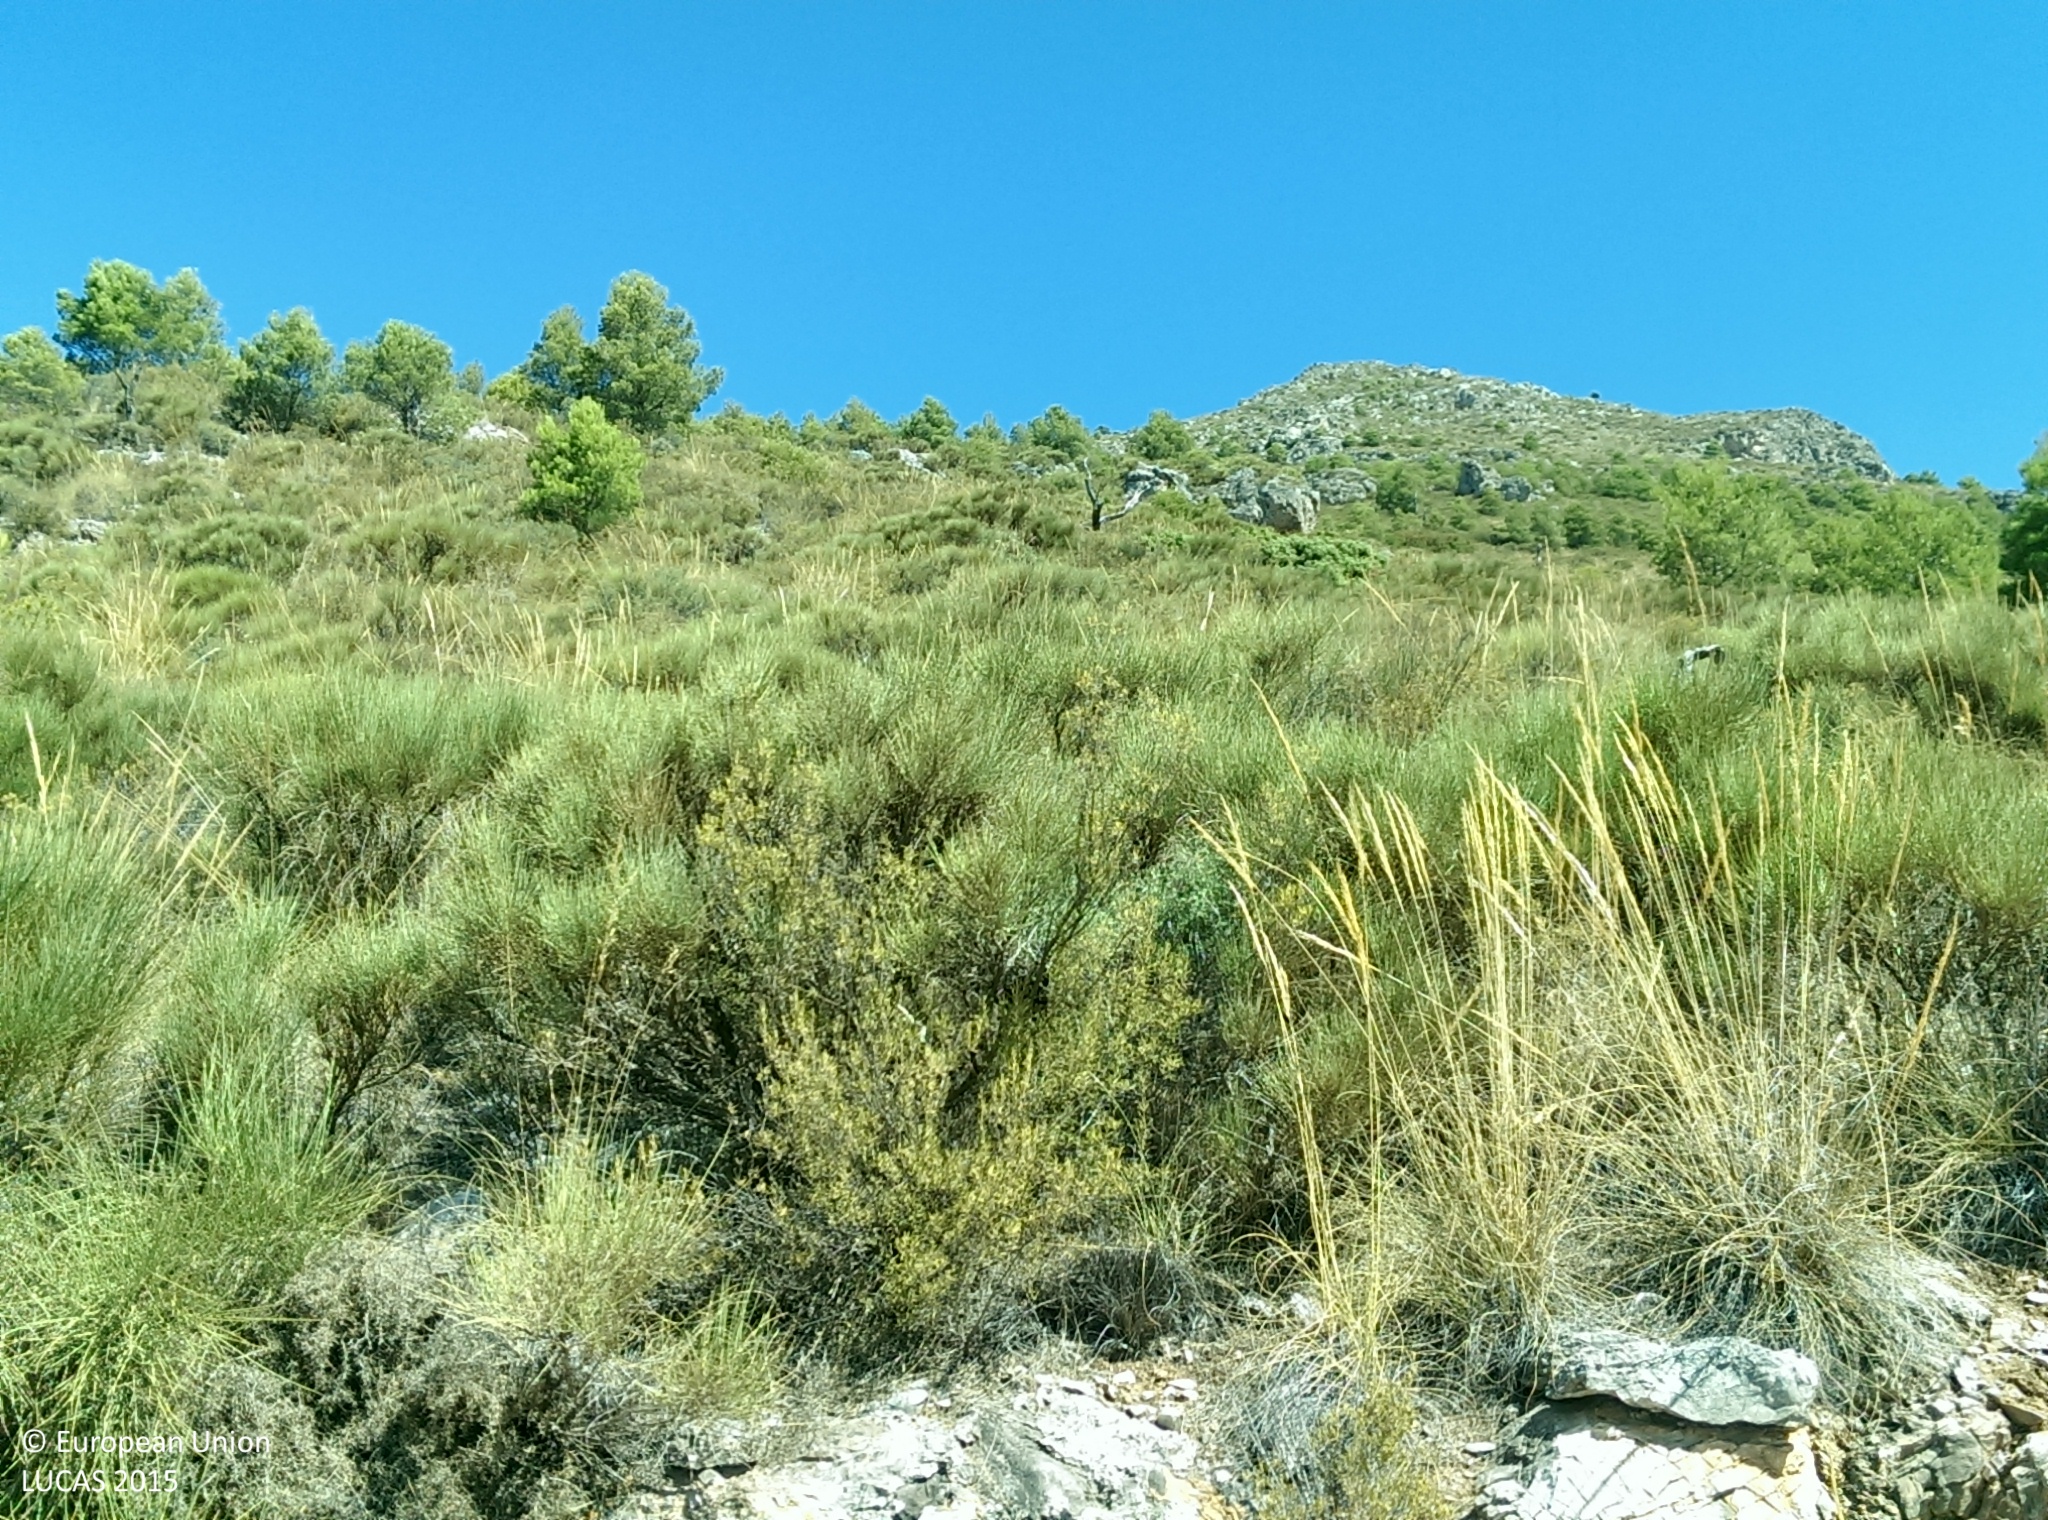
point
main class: Shrubland
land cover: Shrubland with sparse tree cover
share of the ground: > 75 %
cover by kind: shrubs 90 %, coniferous forest trees 5 %, herbaceous plants 5 %
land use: Semi-natural and natural areas not in use
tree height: < 5 m
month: August
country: ES
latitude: 36.8736
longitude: -3.6148
